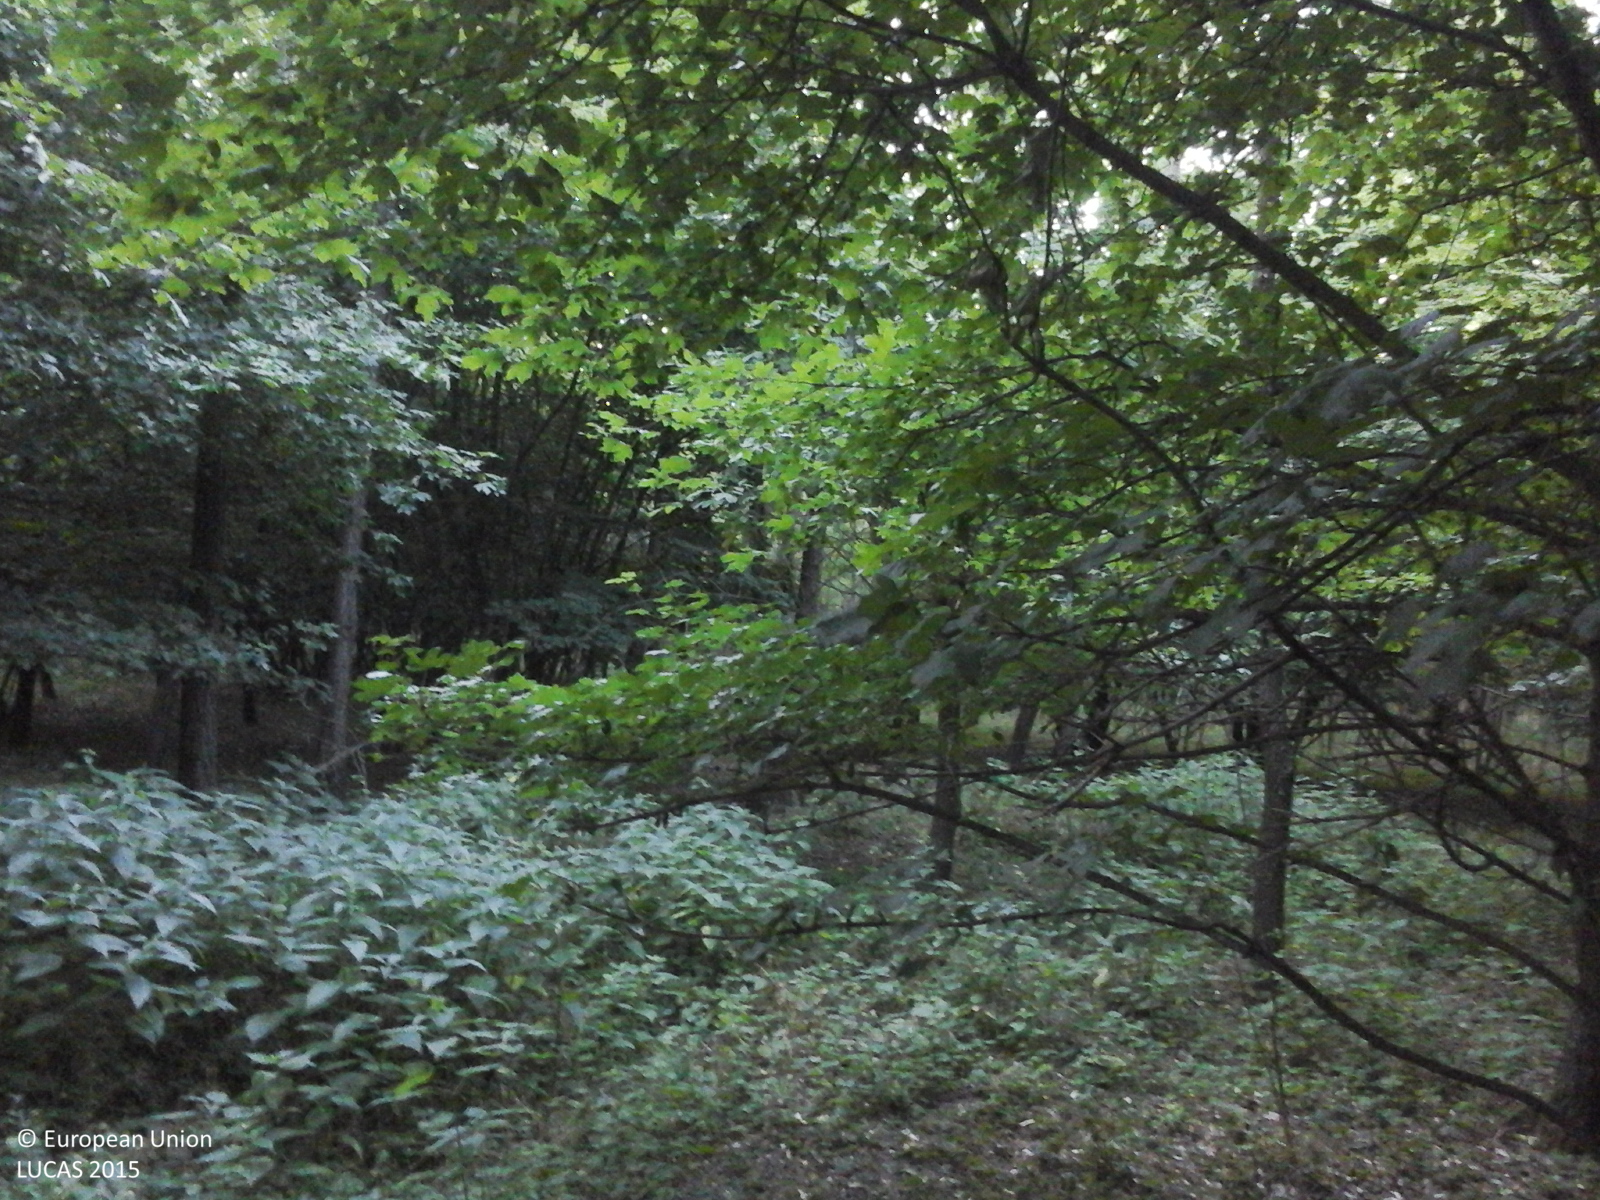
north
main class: Woodland
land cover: Broadleaved woodland
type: mesophytic deciduous forest
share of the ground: > 75 %
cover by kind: broadleaved forest trees 90 %, herbaceous plants 10 %
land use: Forestry
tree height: > 5 m
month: June
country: RO
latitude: 47.4071
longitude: 27.2172
